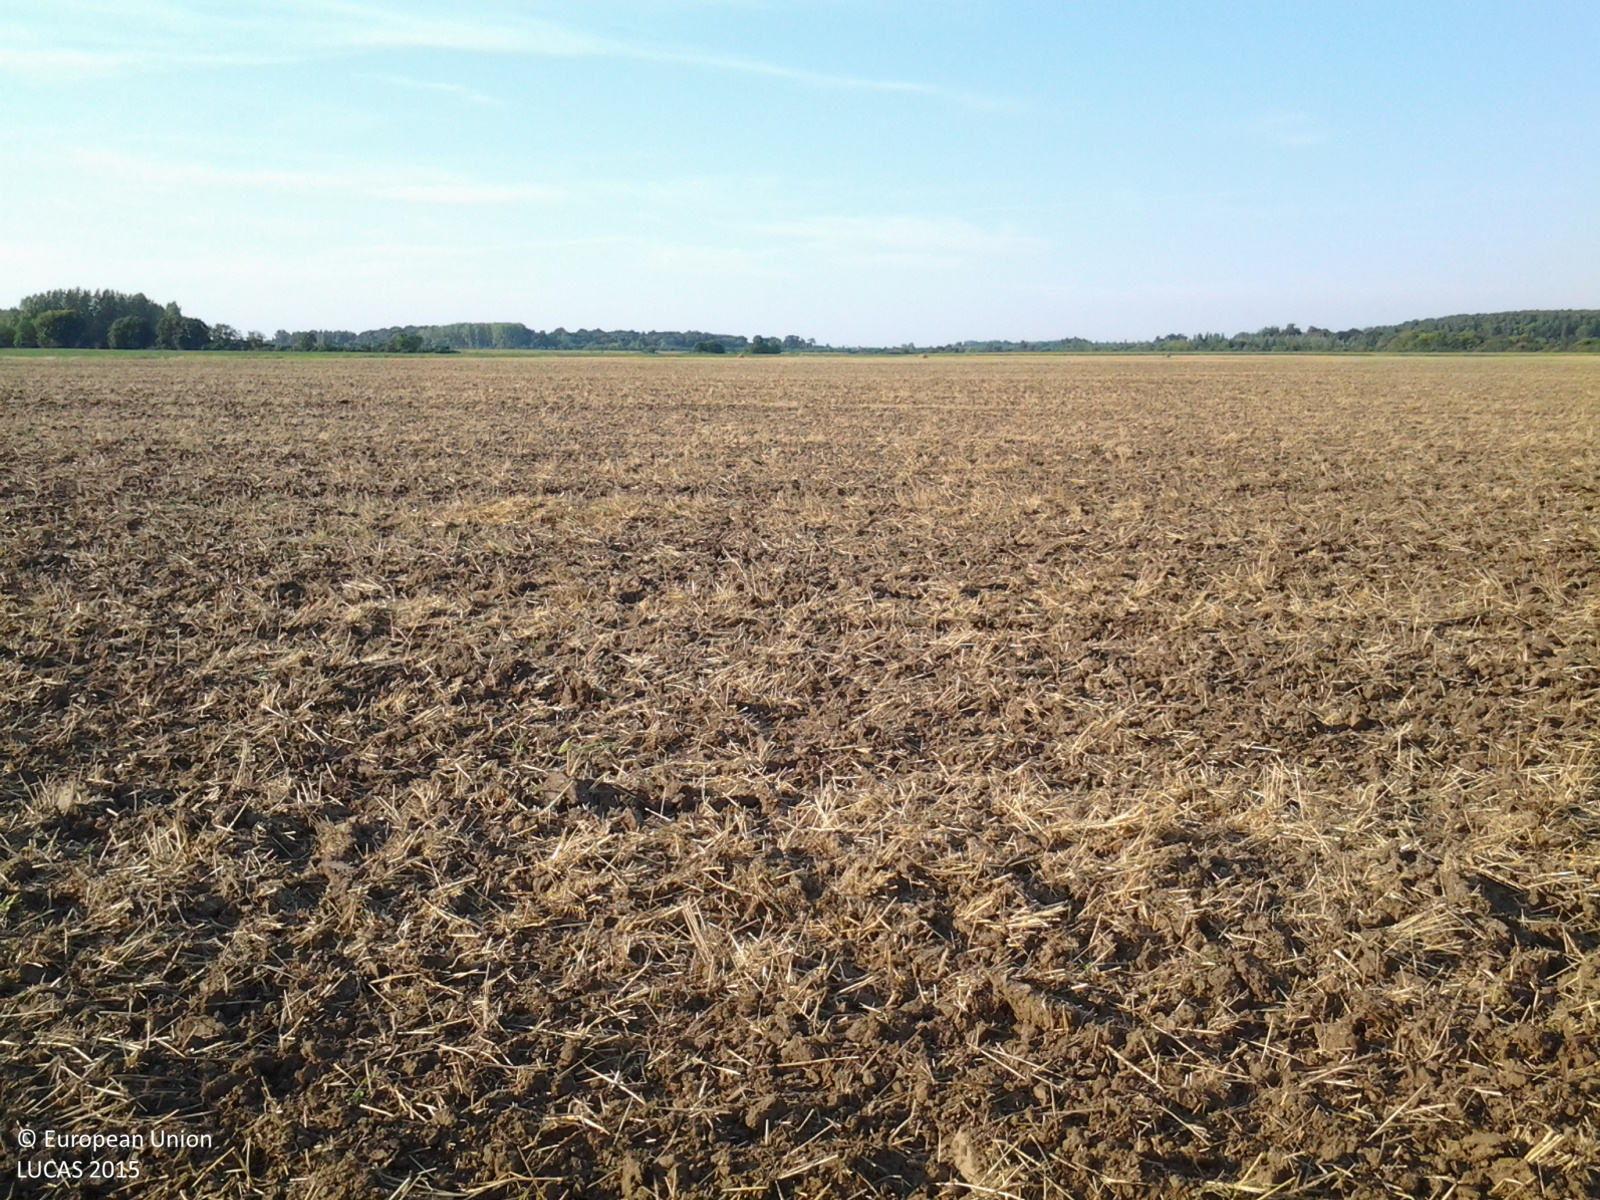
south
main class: Cropland
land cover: Common wheat
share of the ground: < 10 %
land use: Agriculture (excluding fallow land and kitchen gardens)
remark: Harvested field
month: August
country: HU
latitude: 46.9020
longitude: 21.5797
